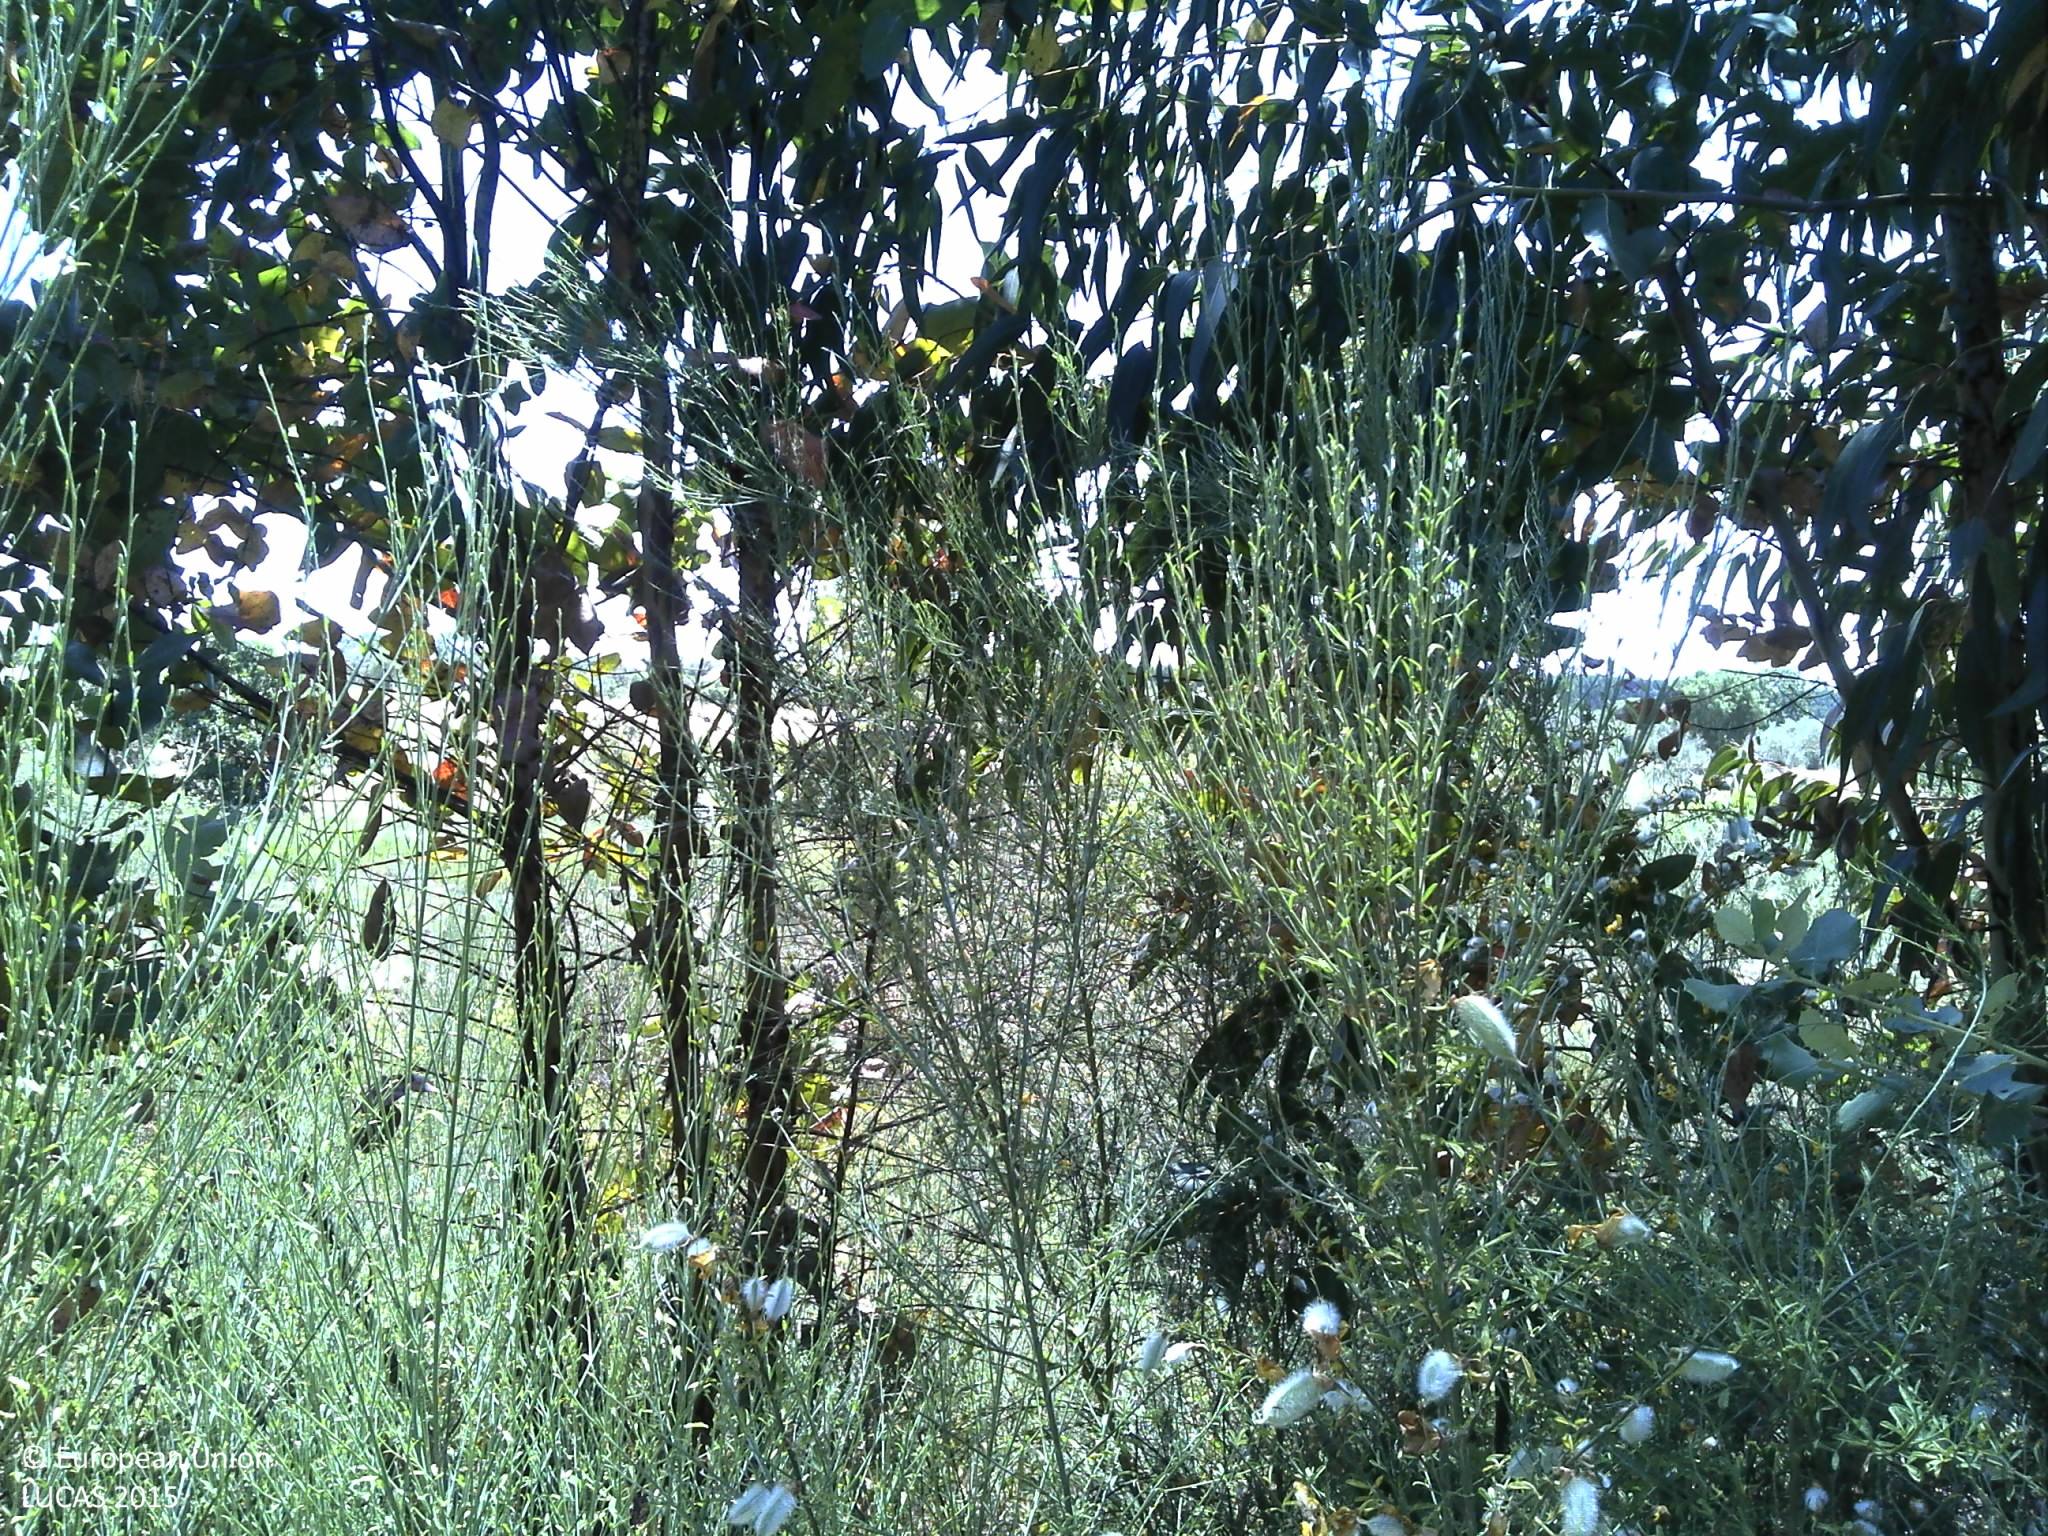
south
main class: Woodland
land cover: Broadleaved woodland
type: exotic forest
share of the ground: 50 - 75 %
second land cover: Shrubland without tree cover
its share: > 75 %
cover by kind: broadleaved forest trees 75 %, shrubs 25 %
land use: Forestry
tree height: > 5 m
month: May
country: PT
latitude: 39.4688
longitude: -7.7316
